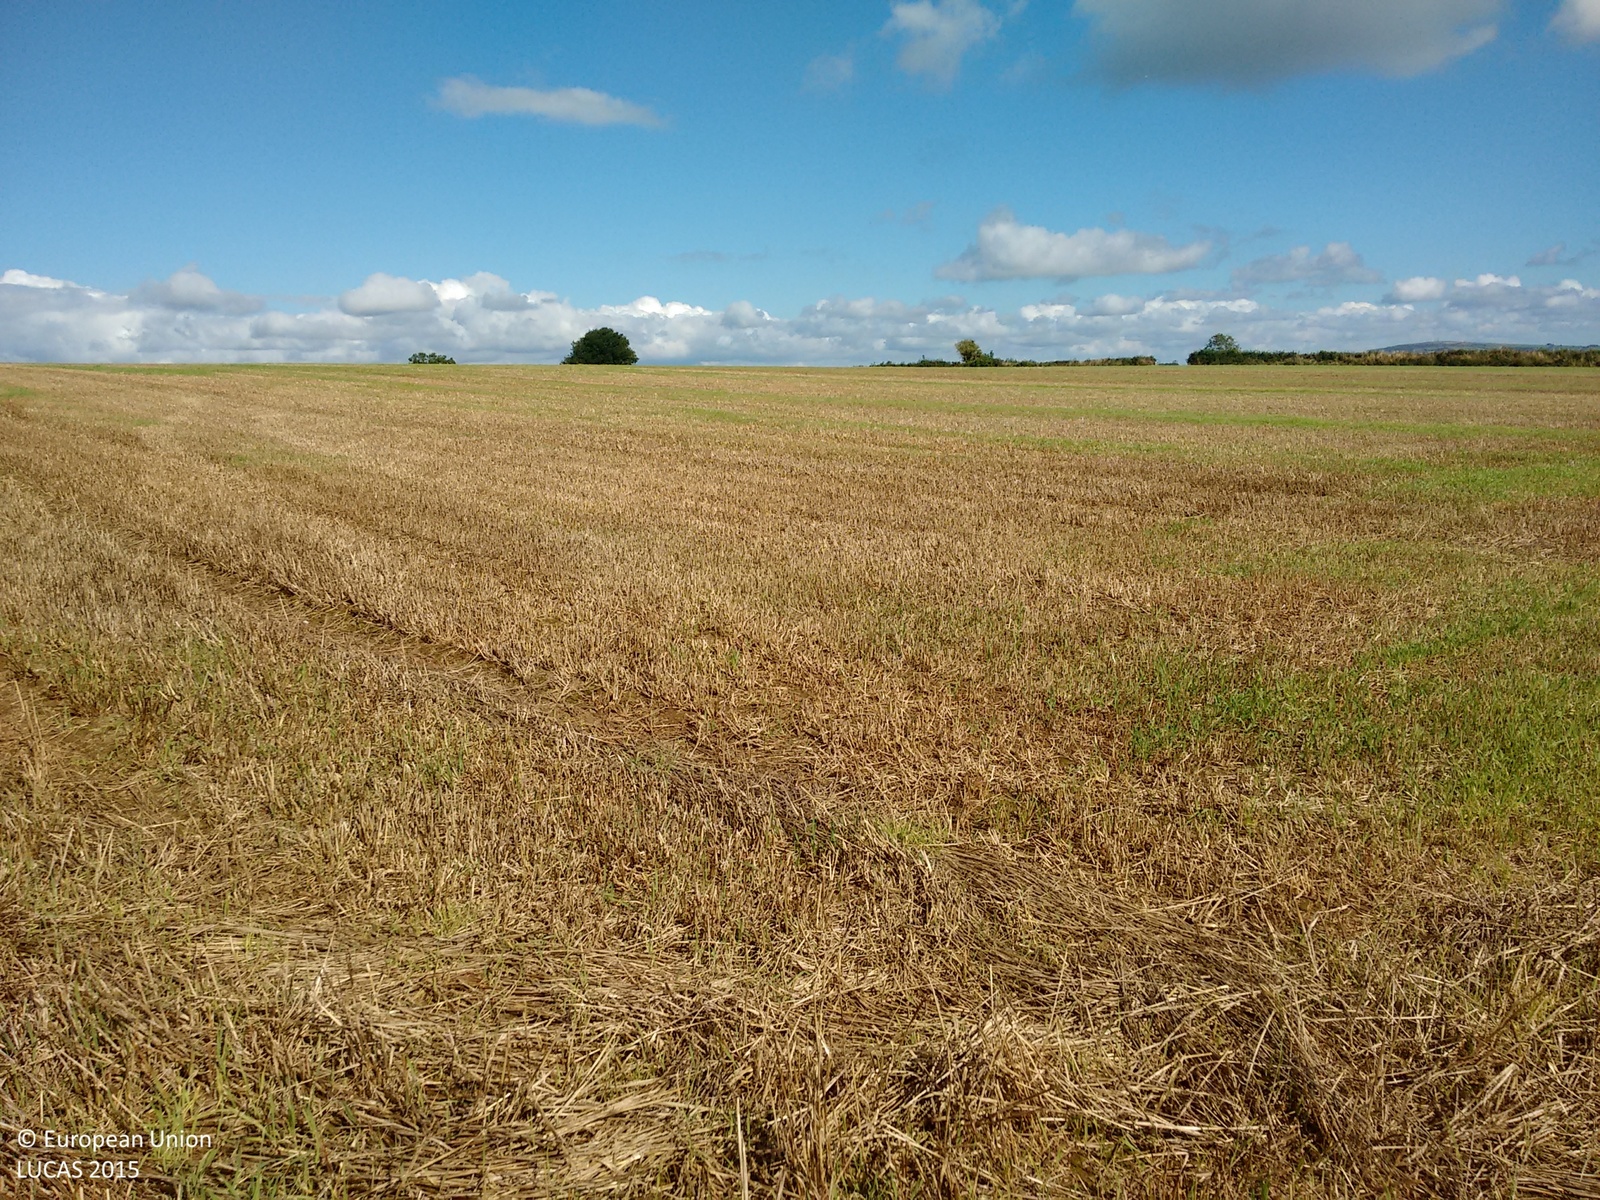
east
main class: Cropland
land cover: Common wheat
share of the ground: 10 - 25 %
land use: Agriculture (excluding fallow land and kitchen gardens)
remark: Harvested field
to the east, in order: Common wheat; Grass margins; Managed hedges; Artificial constructions; Barley
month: September
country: GB
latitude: 50.5573
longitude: -4.4301
